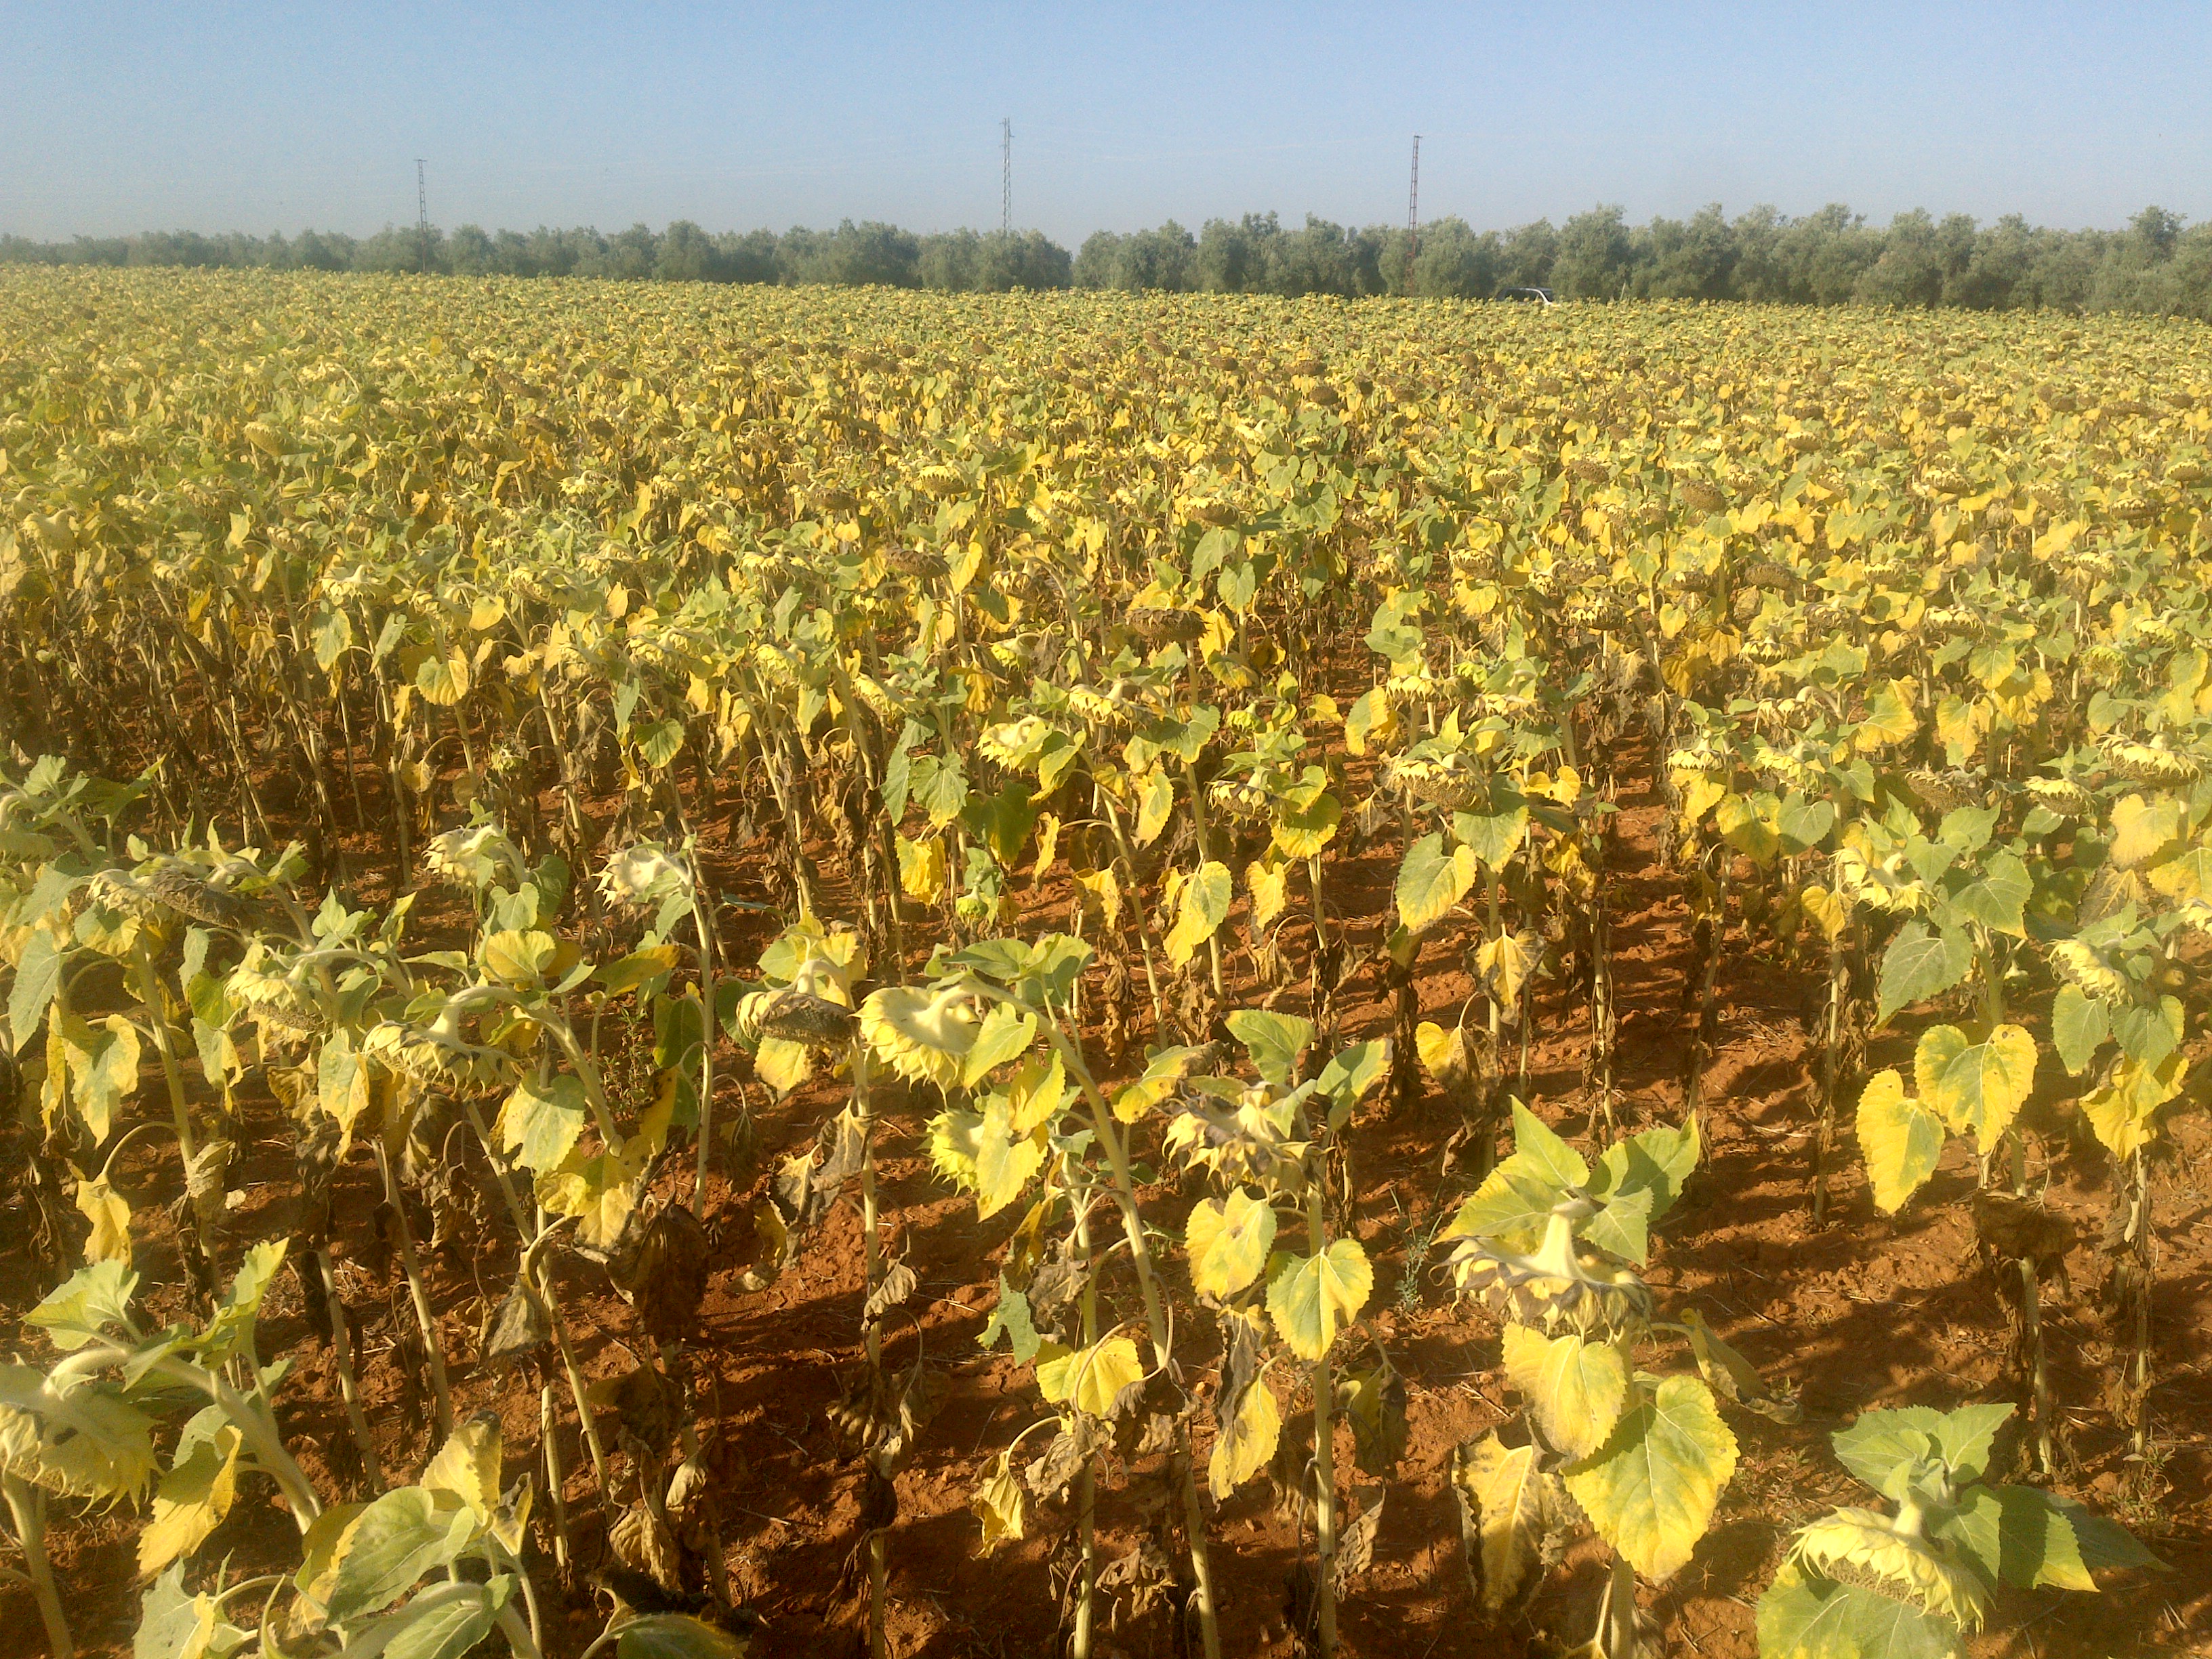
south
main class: Cropland
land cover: Sunflower
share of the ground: > 75 %
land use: Agriculture (excluding fallow land and kitchen gardens)
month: June
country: ES
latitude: 37.6459
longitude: -4.9389
